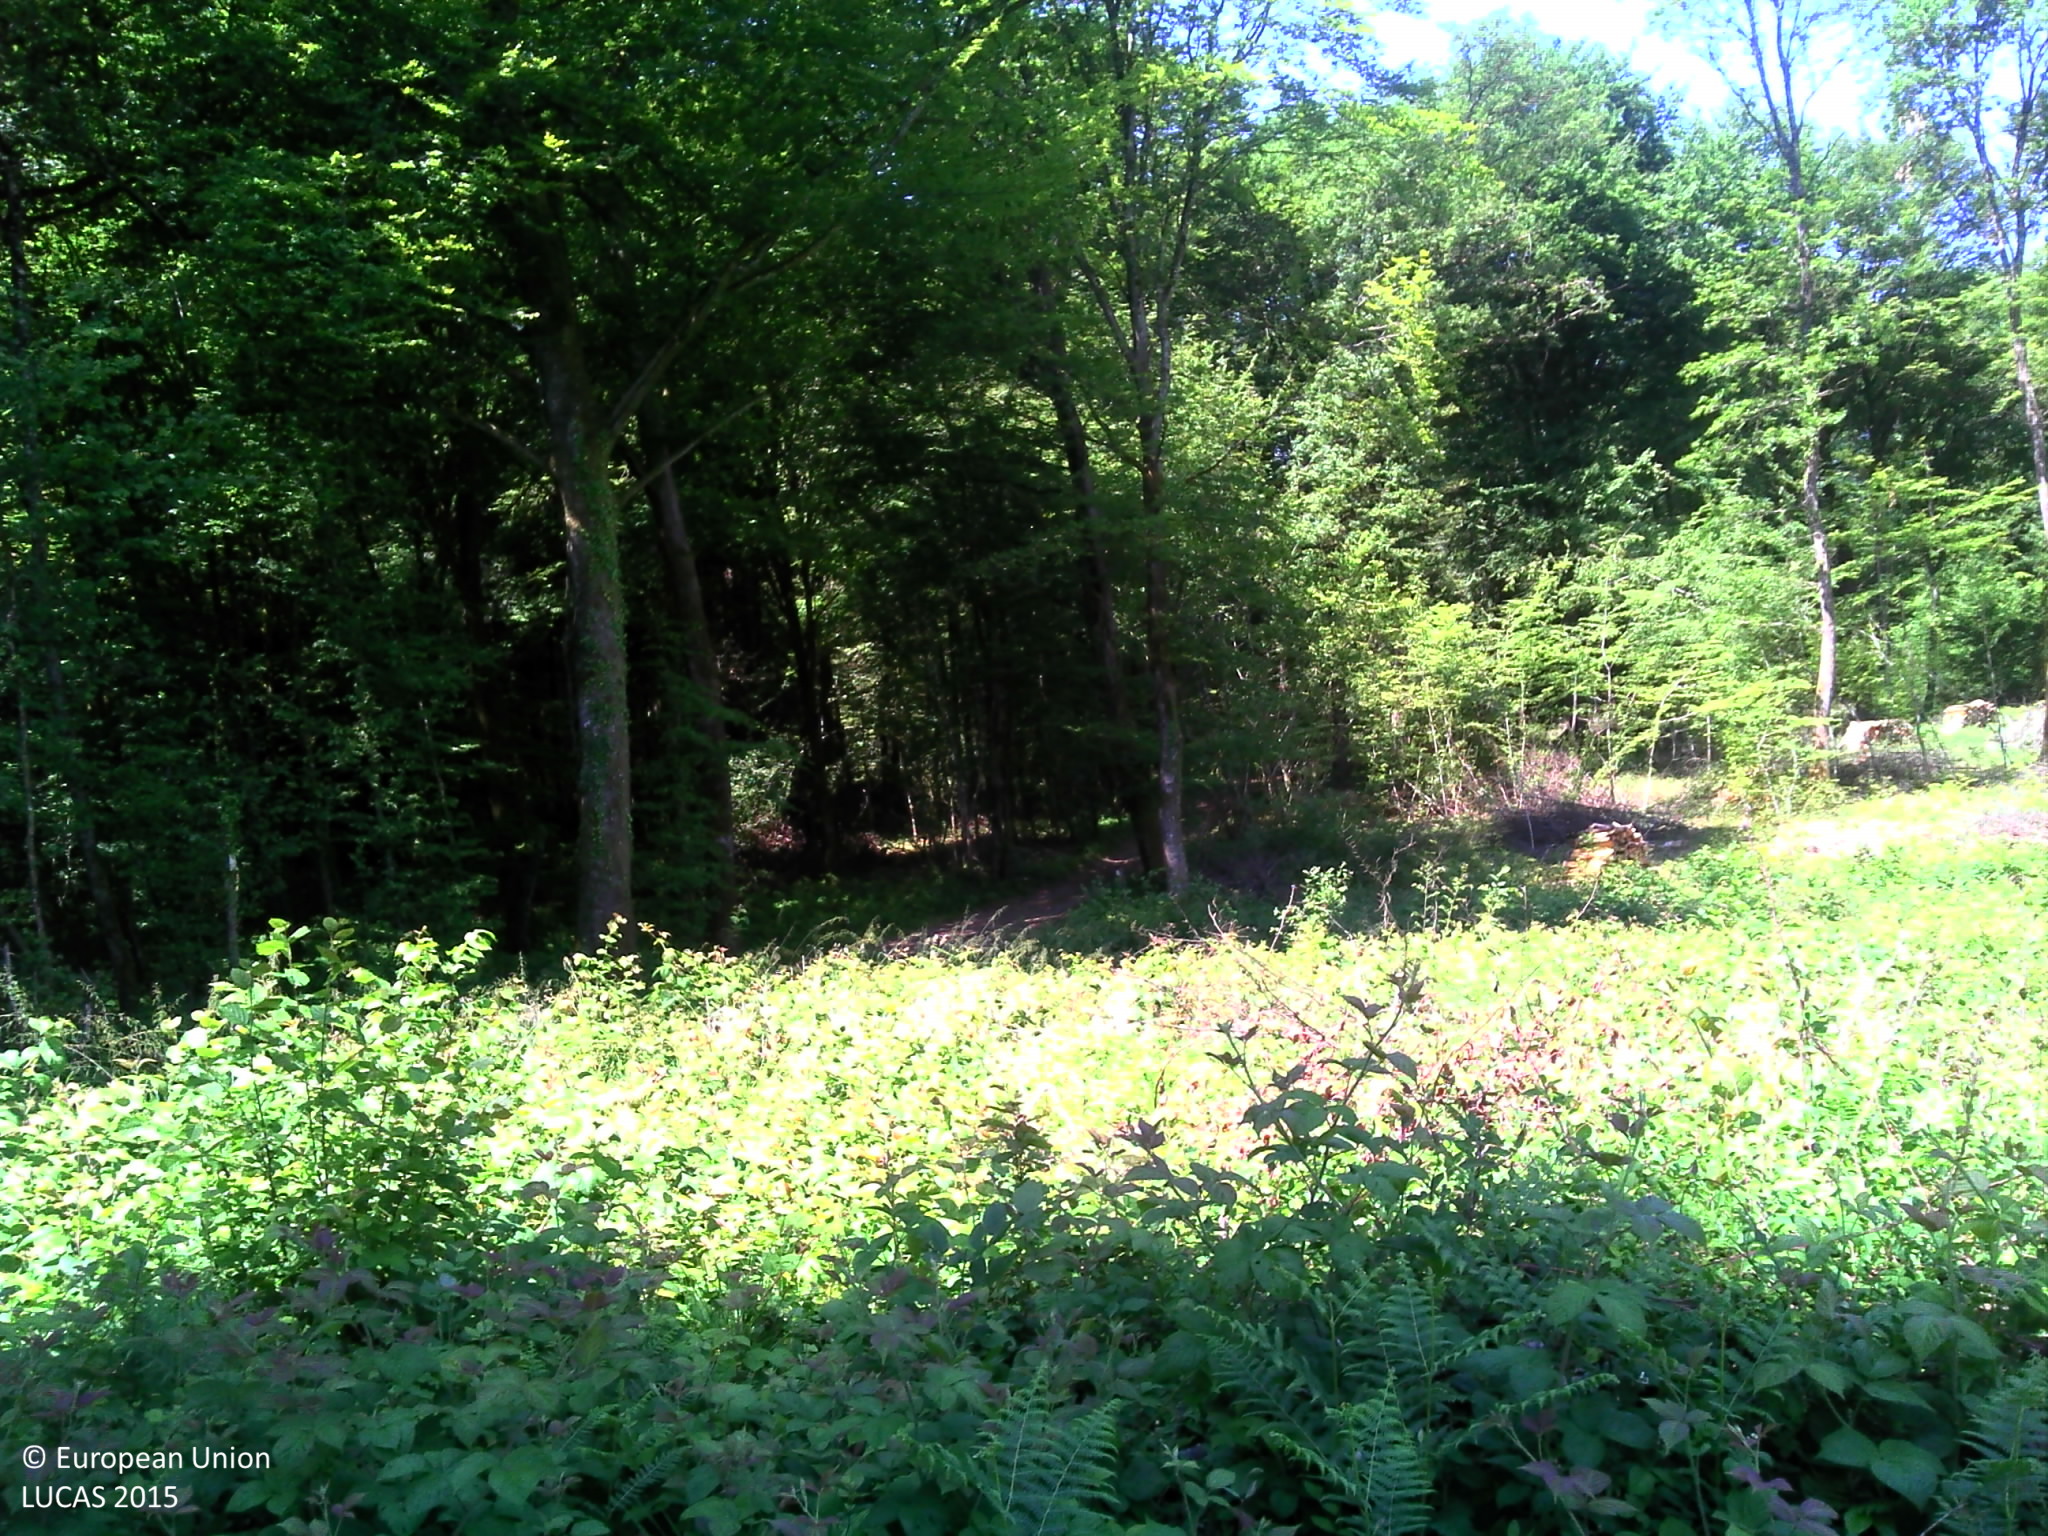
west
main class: Woodland
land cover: Broadleaved woodland
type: mesophytic deciduous forest
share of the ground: > 75 %
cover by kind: broadleaved forest trees 55 %, shrubs 20 %, herbaceous plants 15 %, coniferous forest trees 5 %, unconsolidated bare surface 5 %
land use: Forestry
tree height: < 5 m
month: June
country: FR
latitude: 47.5933
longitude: 6.0249
